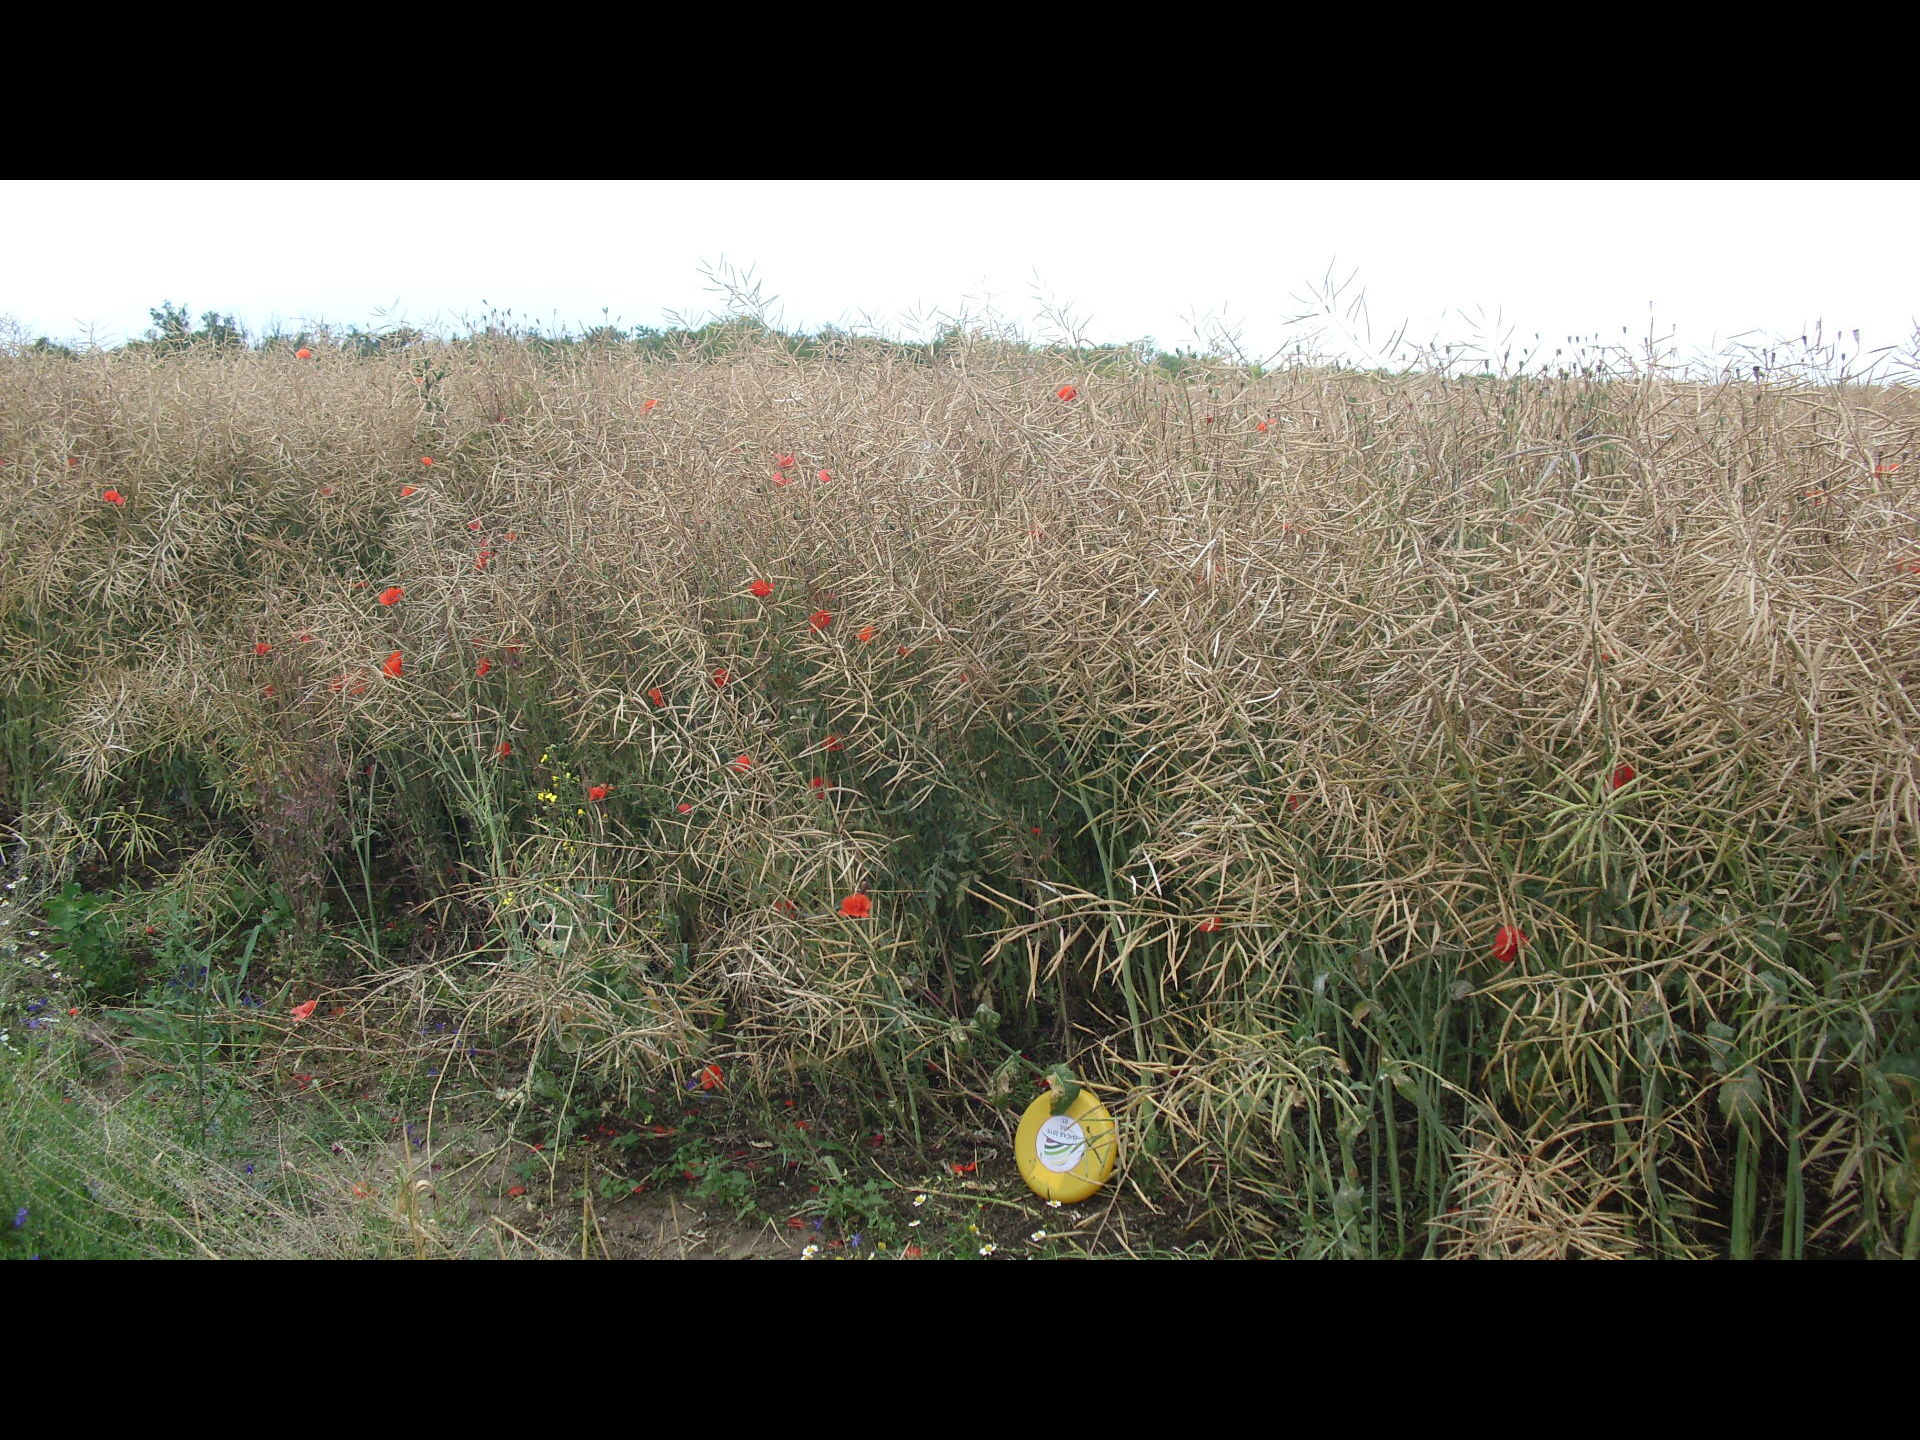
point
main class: Cropland
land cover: Rape and turnip rape
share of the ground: > 75 %
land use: Agriculture (excluding fallow land and kitchen gardens)
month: June
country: BG
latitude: 43.6371
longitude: 23.5705
